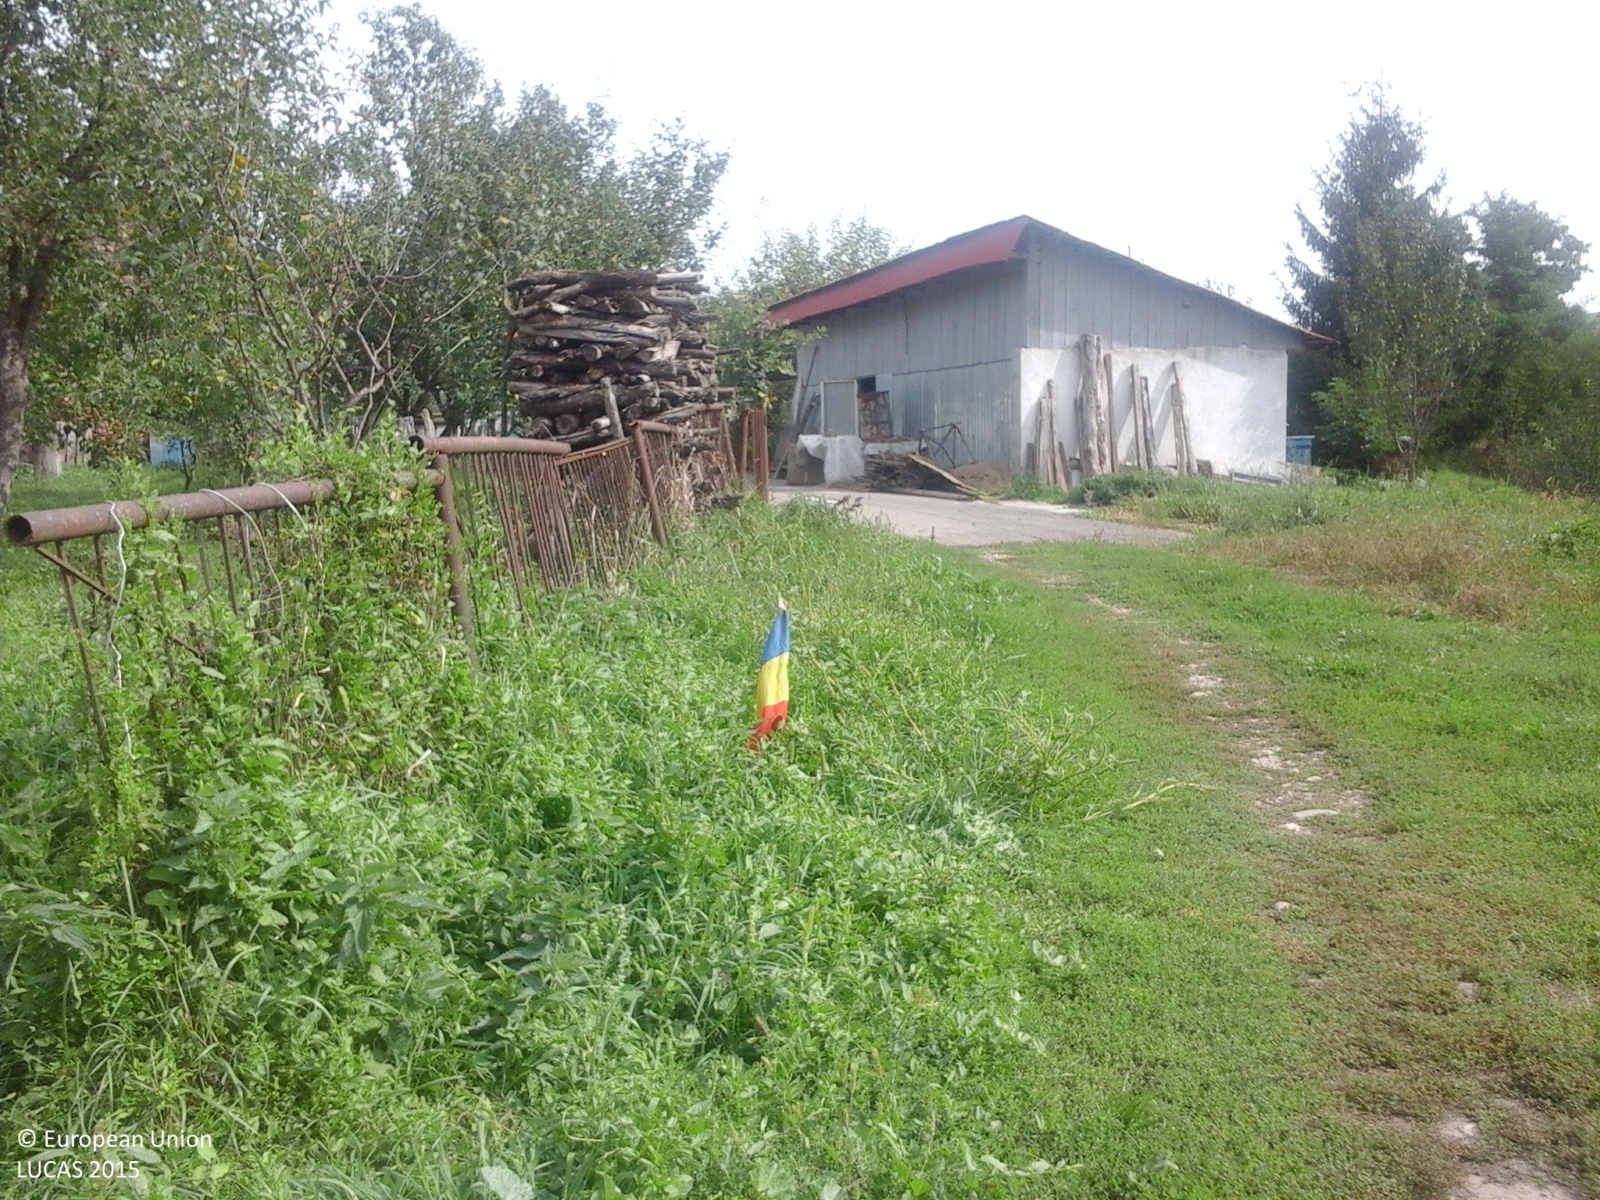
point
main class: Grassland
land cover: Spontaneously vegetated surfaces
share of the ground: > 75 %
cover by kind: herbaceous plants 100 %
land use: Fallow land
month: September
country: RO
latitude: 46.9294
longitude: 23.6670
